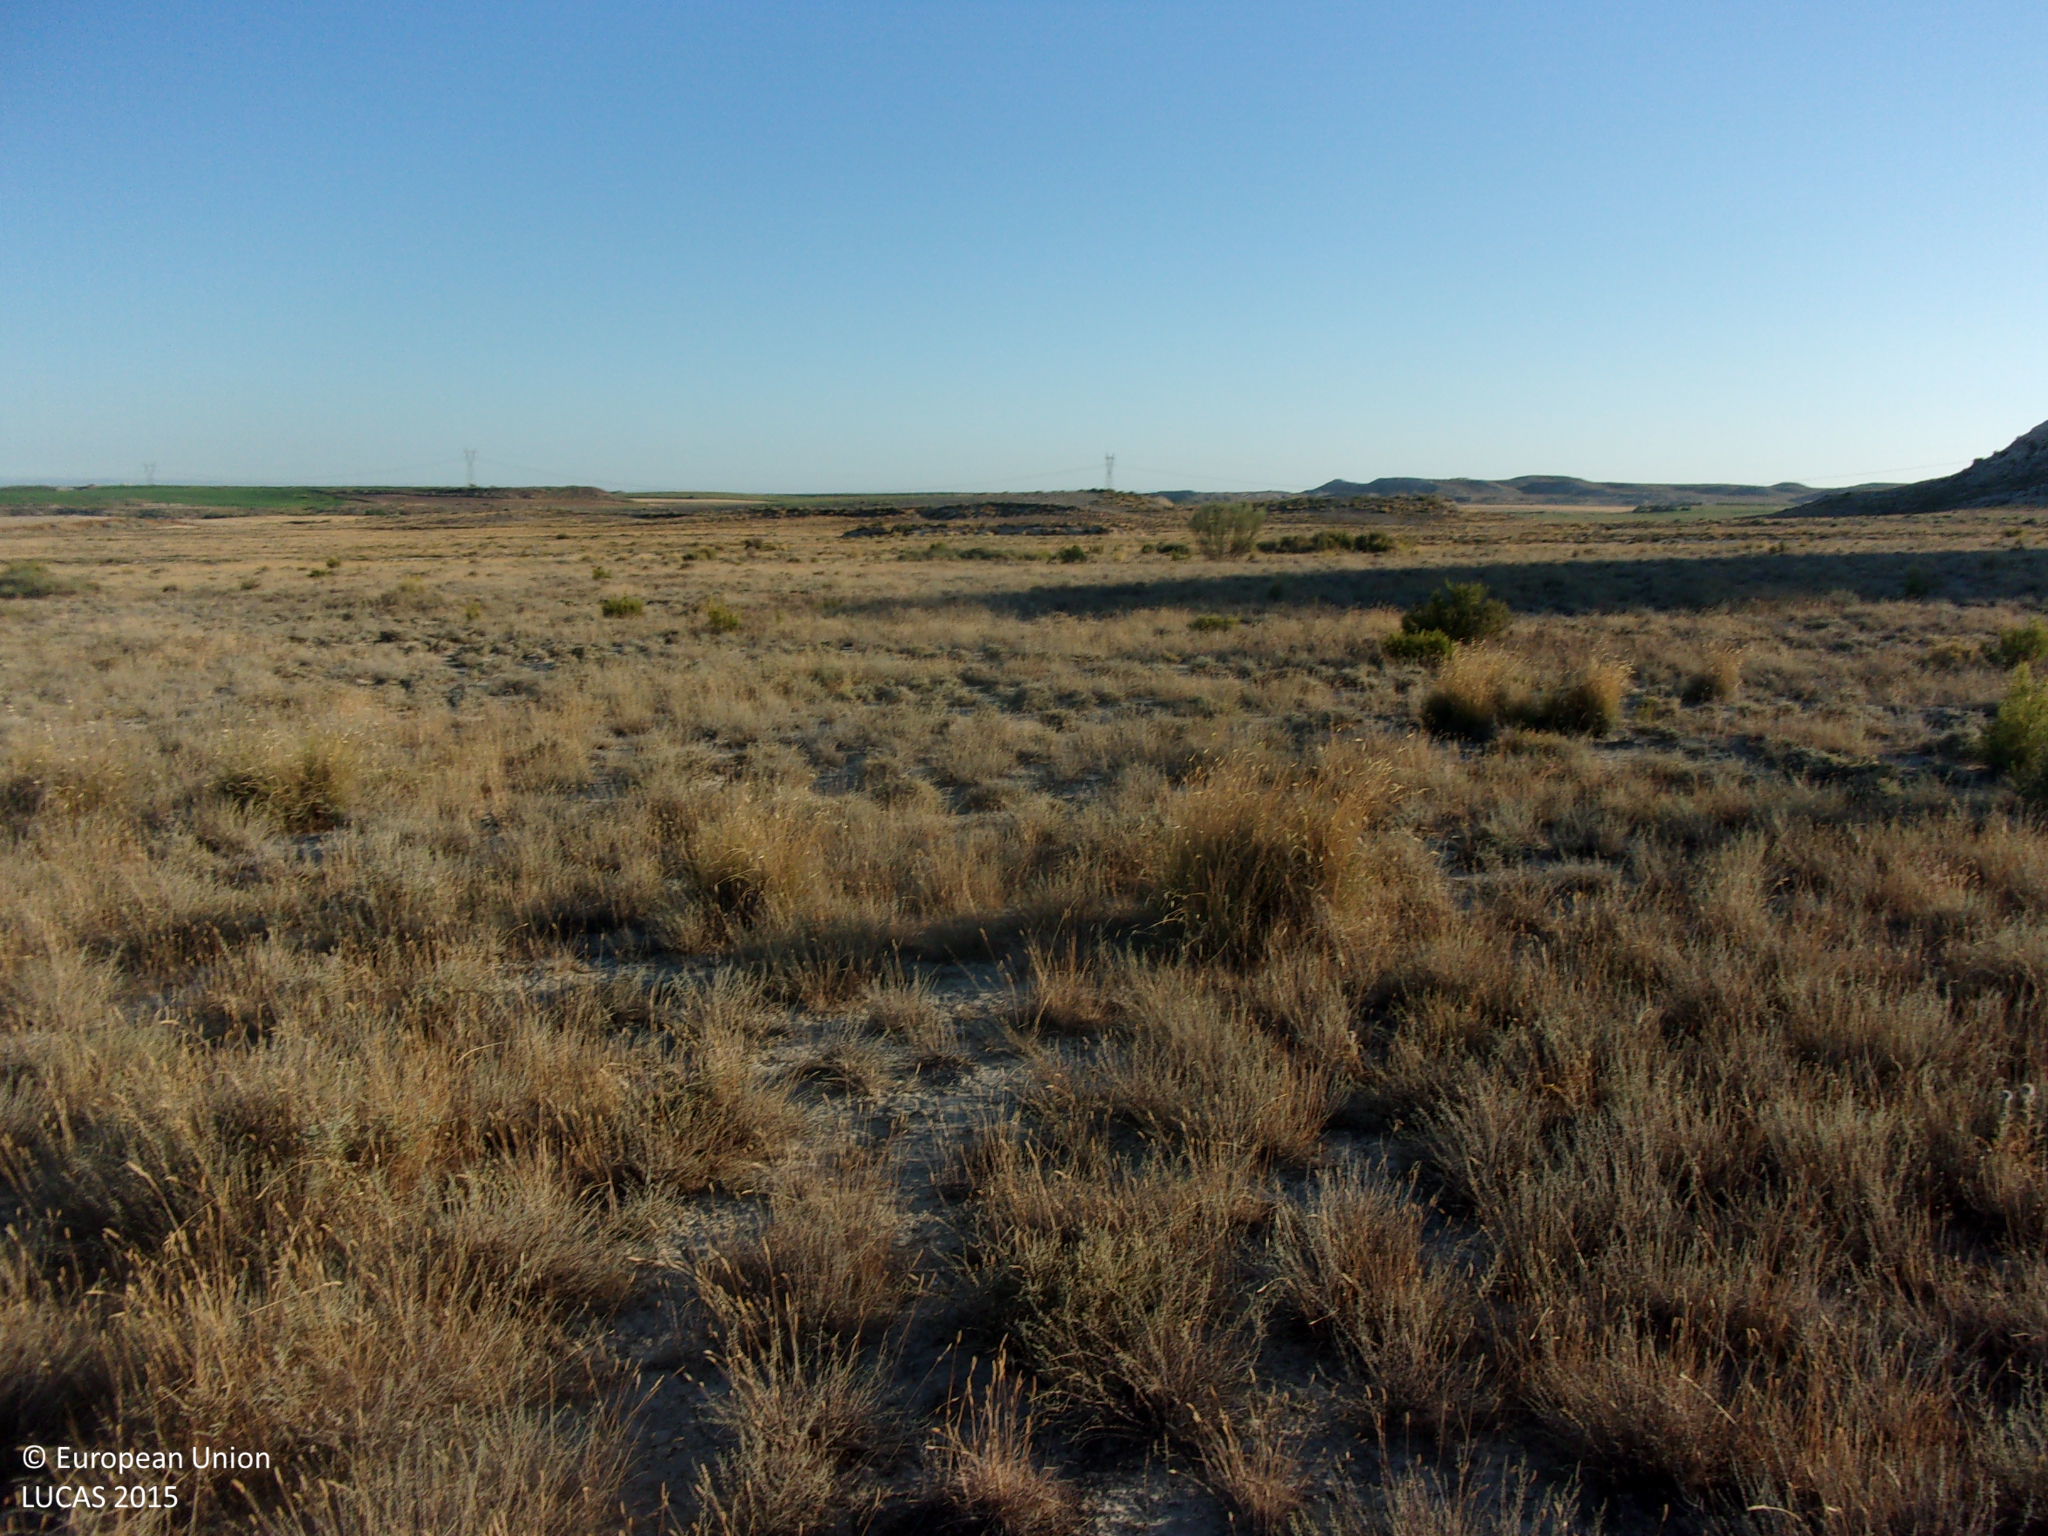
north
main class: Shrubland
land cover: Shrubland without tree cover
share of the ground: > 75 %
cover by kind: shrubs 80 %, herbaceous plants 10 %, consolidated bare surface 10 %
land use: Abandoned areas
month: July
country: ES
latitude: 42.0031
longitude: -1.1224
